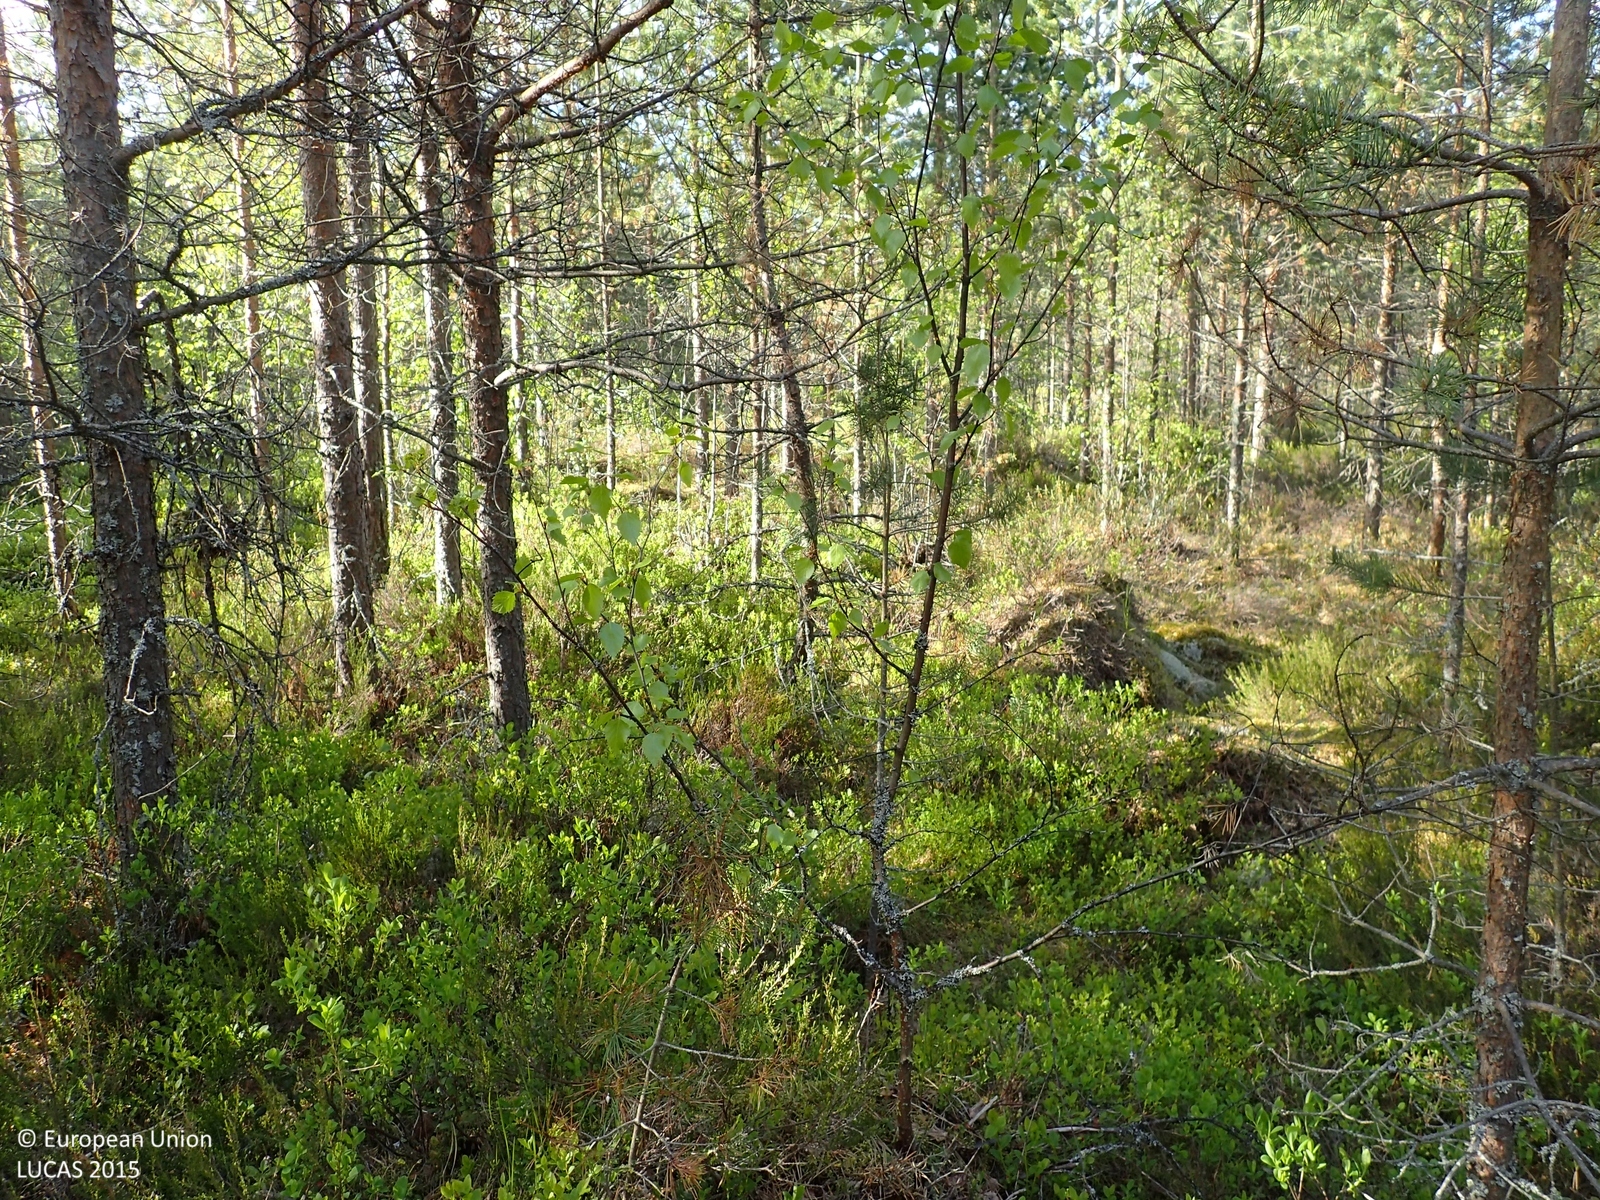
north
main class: Woodland
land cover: Pine dominated coniferous woodland
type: boreal forest
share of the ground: > 75 %
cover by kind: coniferous forest trees 80 %, shrubs 15 %, broadleaved forest trees 5 %
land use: Forestry
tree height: < 5 m
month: June
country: FI
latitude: 62.3763
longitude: 22.5658
